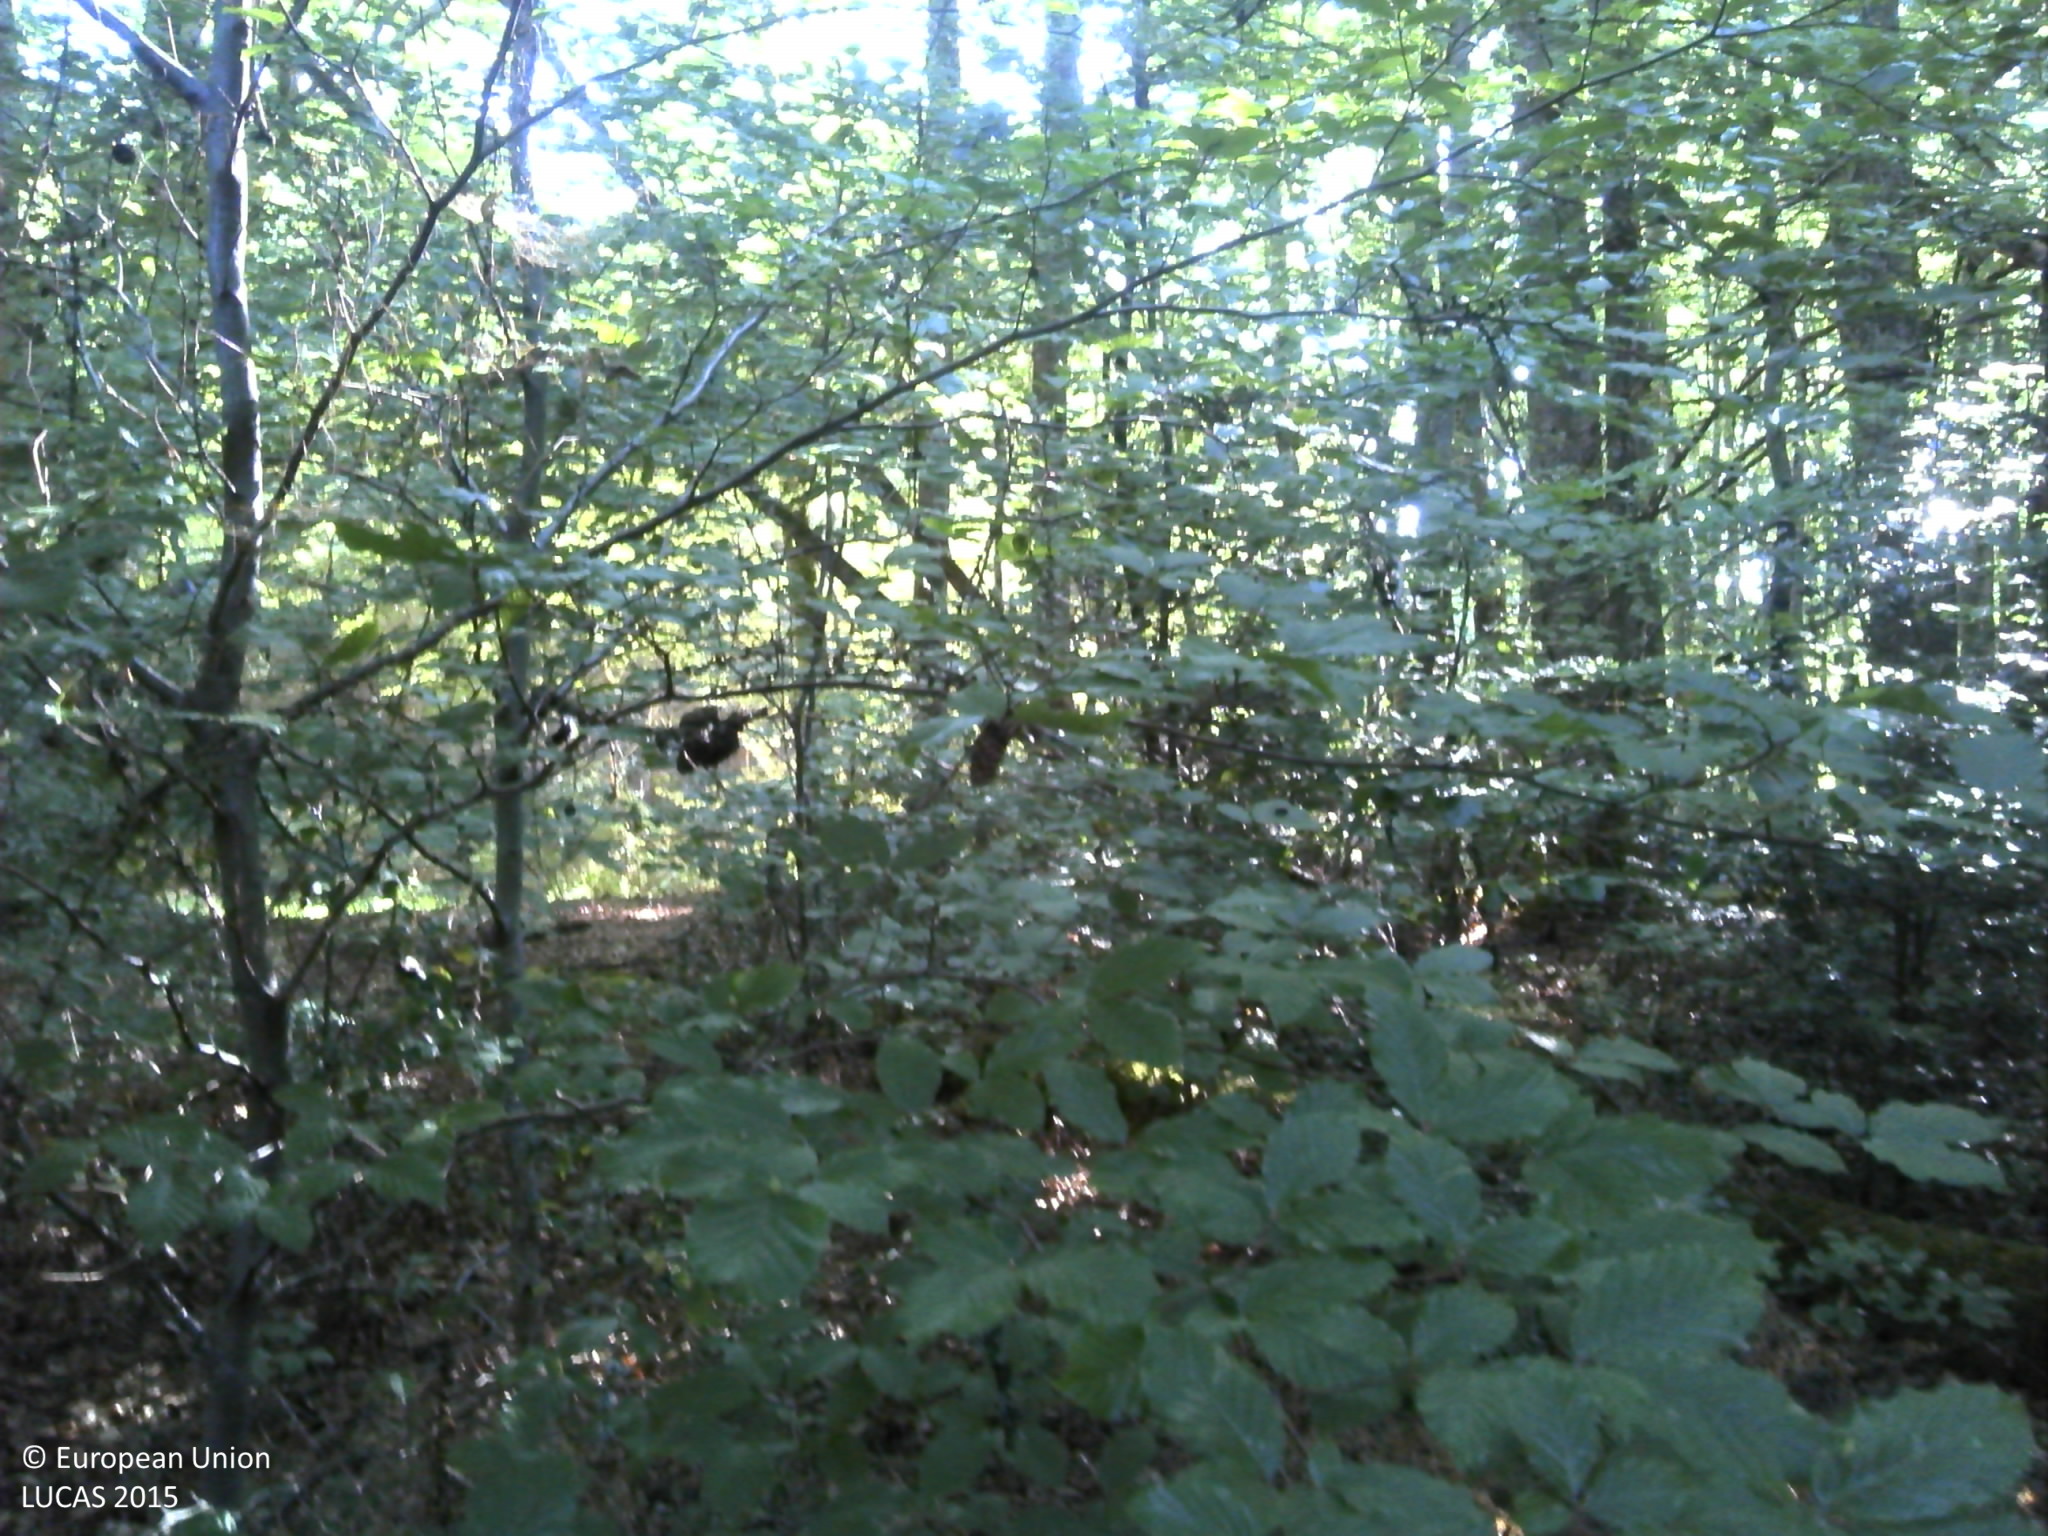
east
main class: Woodland
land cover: Other mixed woodland
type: mountainous beech forest
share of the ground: > 75 %
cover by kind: broadleaved forest trees 40 %, coniferous forest trees 30 %, unconsolidated bare surface 20 %, herbaceous plants 5 %, lichens and mosses 5 %
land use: Forestry
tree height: > 5 m
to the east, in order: Other mixed woodland; Fences; Broadleaved woodland; Ditches and canals; Grass margins; Paved roads, cycling and walking lanes; Grass margins; Ditches and canals; Other coniferous woodland; Tracks; Broadleaved woodland; Tracks; Broadleaved woodland; Tracks; Spontaneously vegetated surfaces; Ditches and canals; Grass margins; Paved roads, cycling and walking lanes; Grass margins; Fences; Grassland without tree/shrub cover
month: August
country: FR
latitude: 45.4665
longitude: 2.4138
